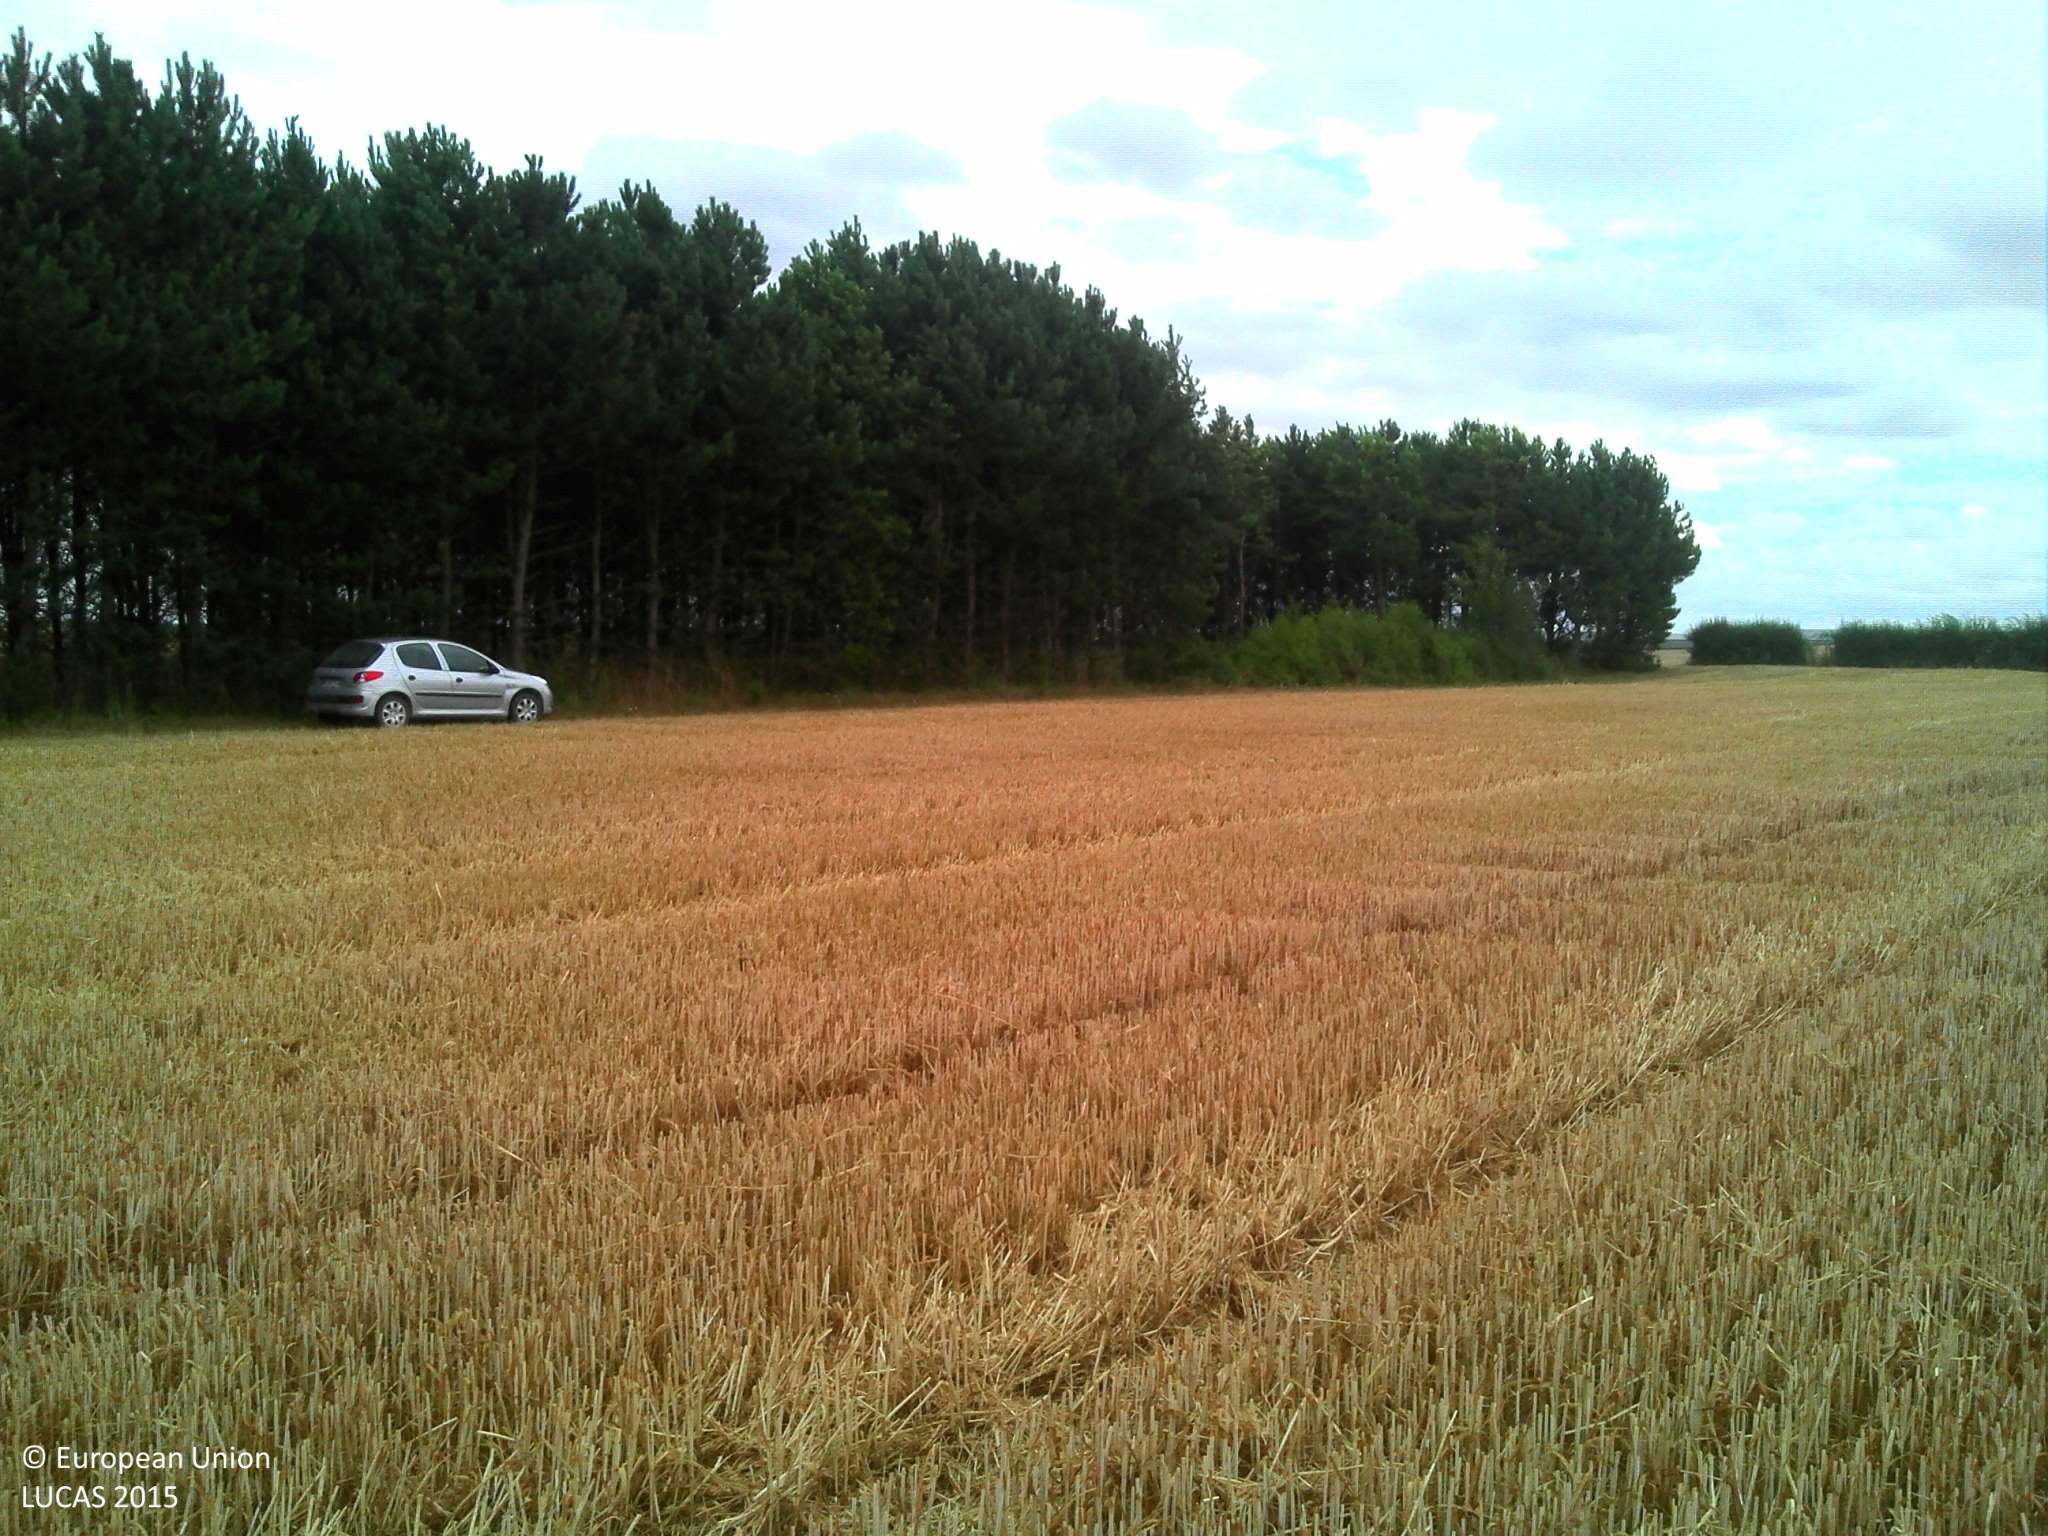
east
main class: Cropland
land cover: Common wheat
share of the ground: > 75 %
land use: Agriculture (excluding fallow land and kitchen gardens)
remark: Harvested field
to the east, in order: Common wheat; Grass margins; Tracks; Grass margins; Other coniferous woodland; Grass margins; Tracks; Grass margins; Common wheat; Grass margins; Tracks; Grass margins; Other bare soil
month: July
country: FR
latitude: 48.7915
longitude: 4.1836
